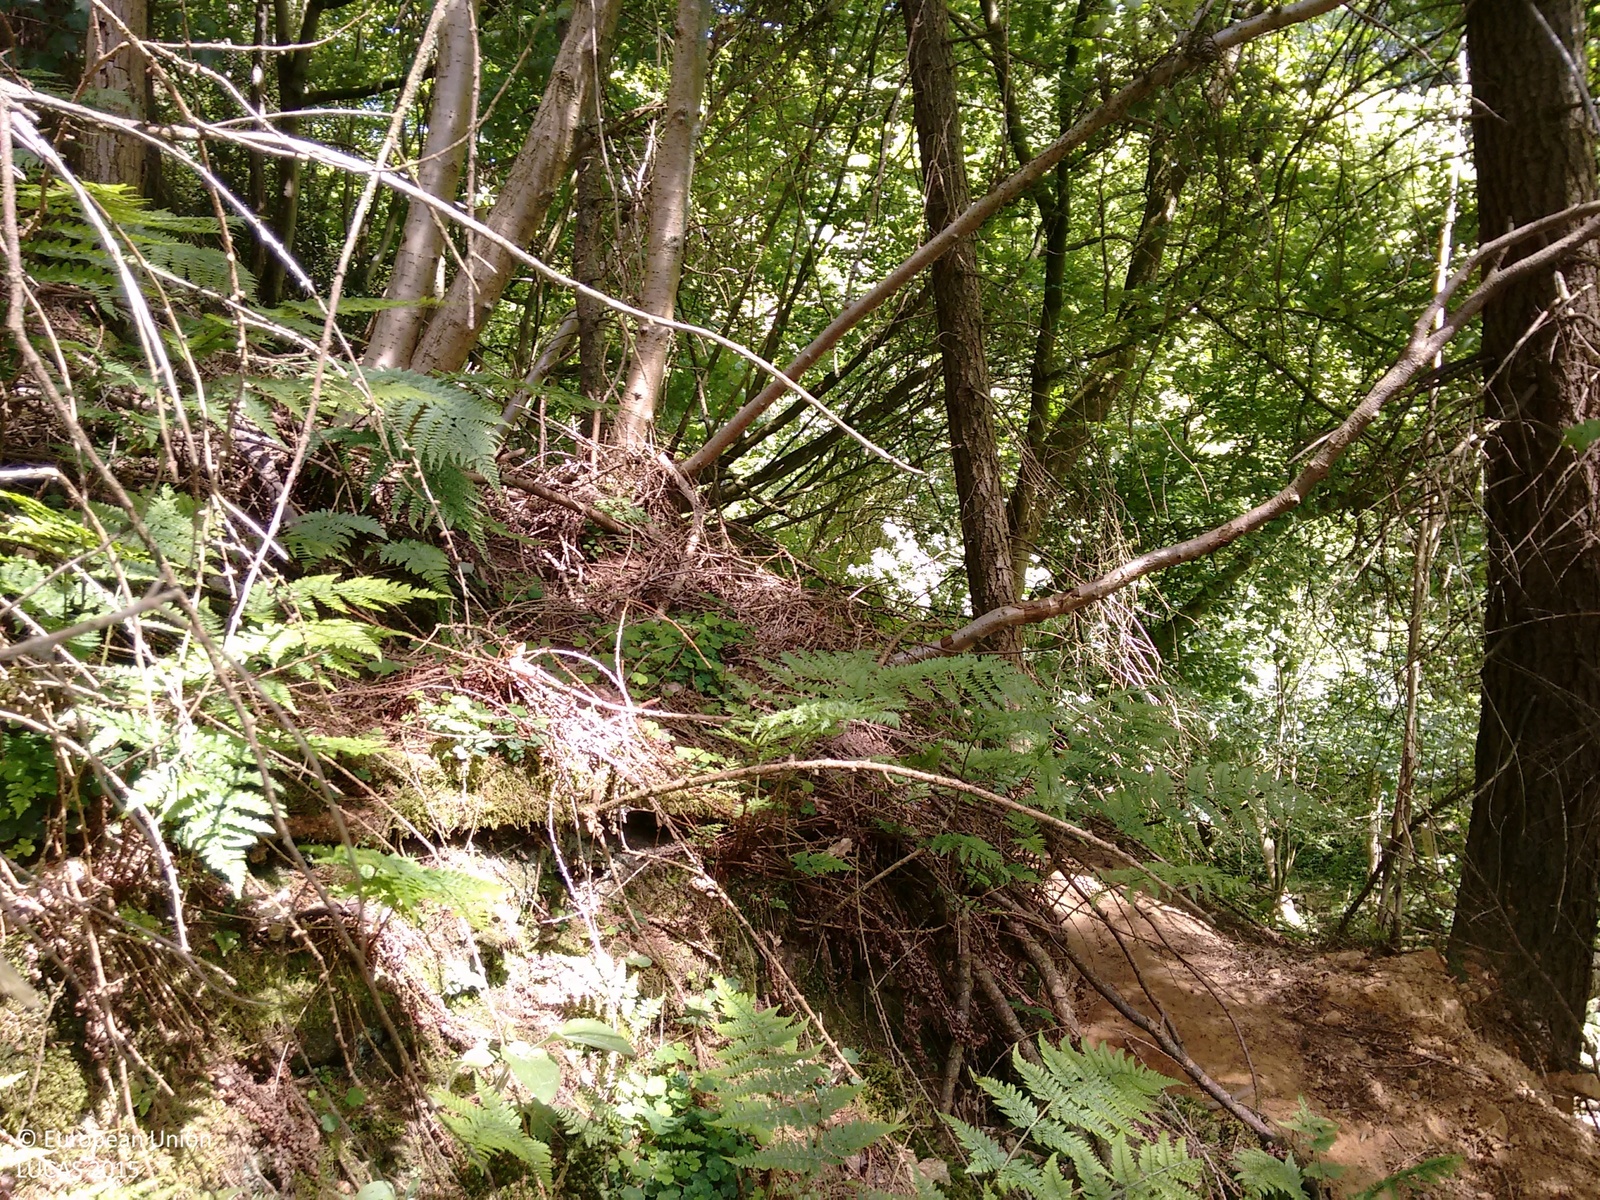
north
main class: Woodland
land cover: Other mixed woodland
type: mesophytic deciduous forest
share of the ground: > 75 %
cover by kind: coniferous forest trees 50 %, broadleaved forest trees 50 %
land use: Sport
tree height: > 5 m
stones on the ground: < 10 %
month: June
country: GB
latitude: 54.2247
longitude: -1.1959
